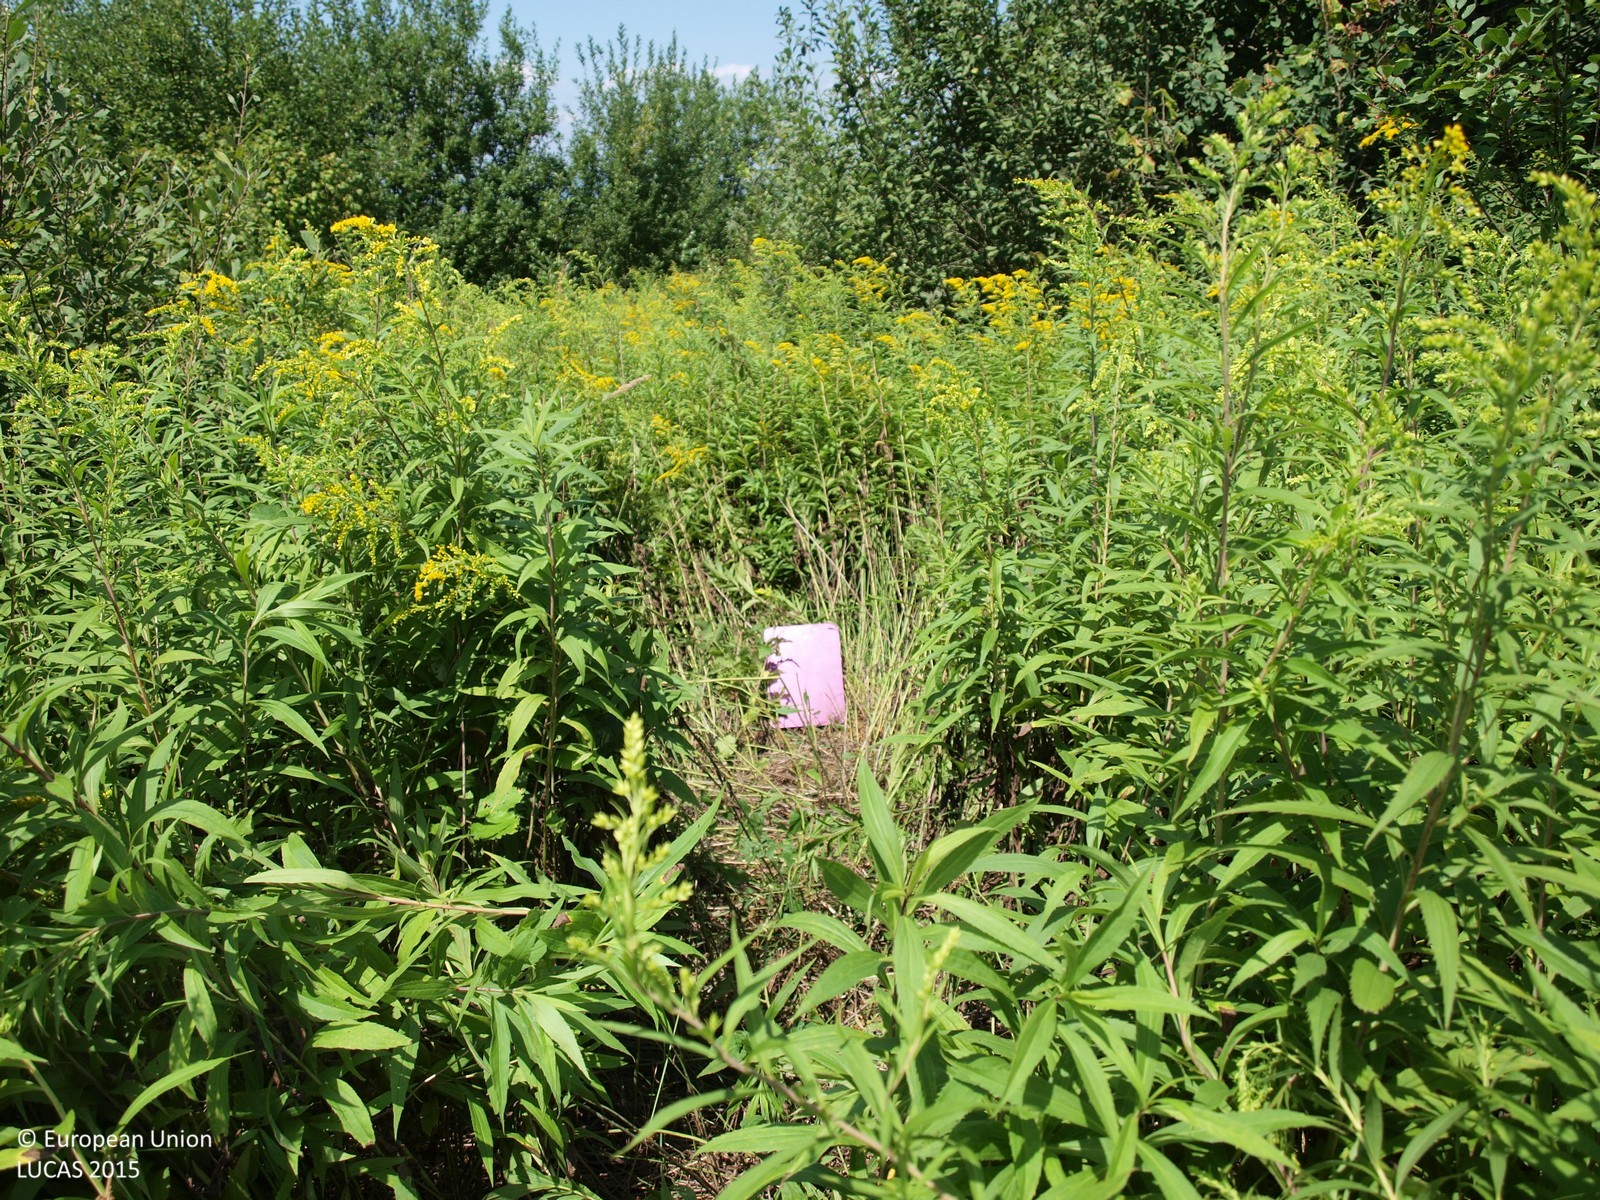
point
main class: Shrubland
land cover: Shrubland with sparse tree cover
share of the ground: > 75 %
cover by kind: shrubs 95 %, broadleaved forest trees 5 %
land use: Abandoned areas
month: August
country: HR
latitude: 45.8616
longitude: 16.2456
